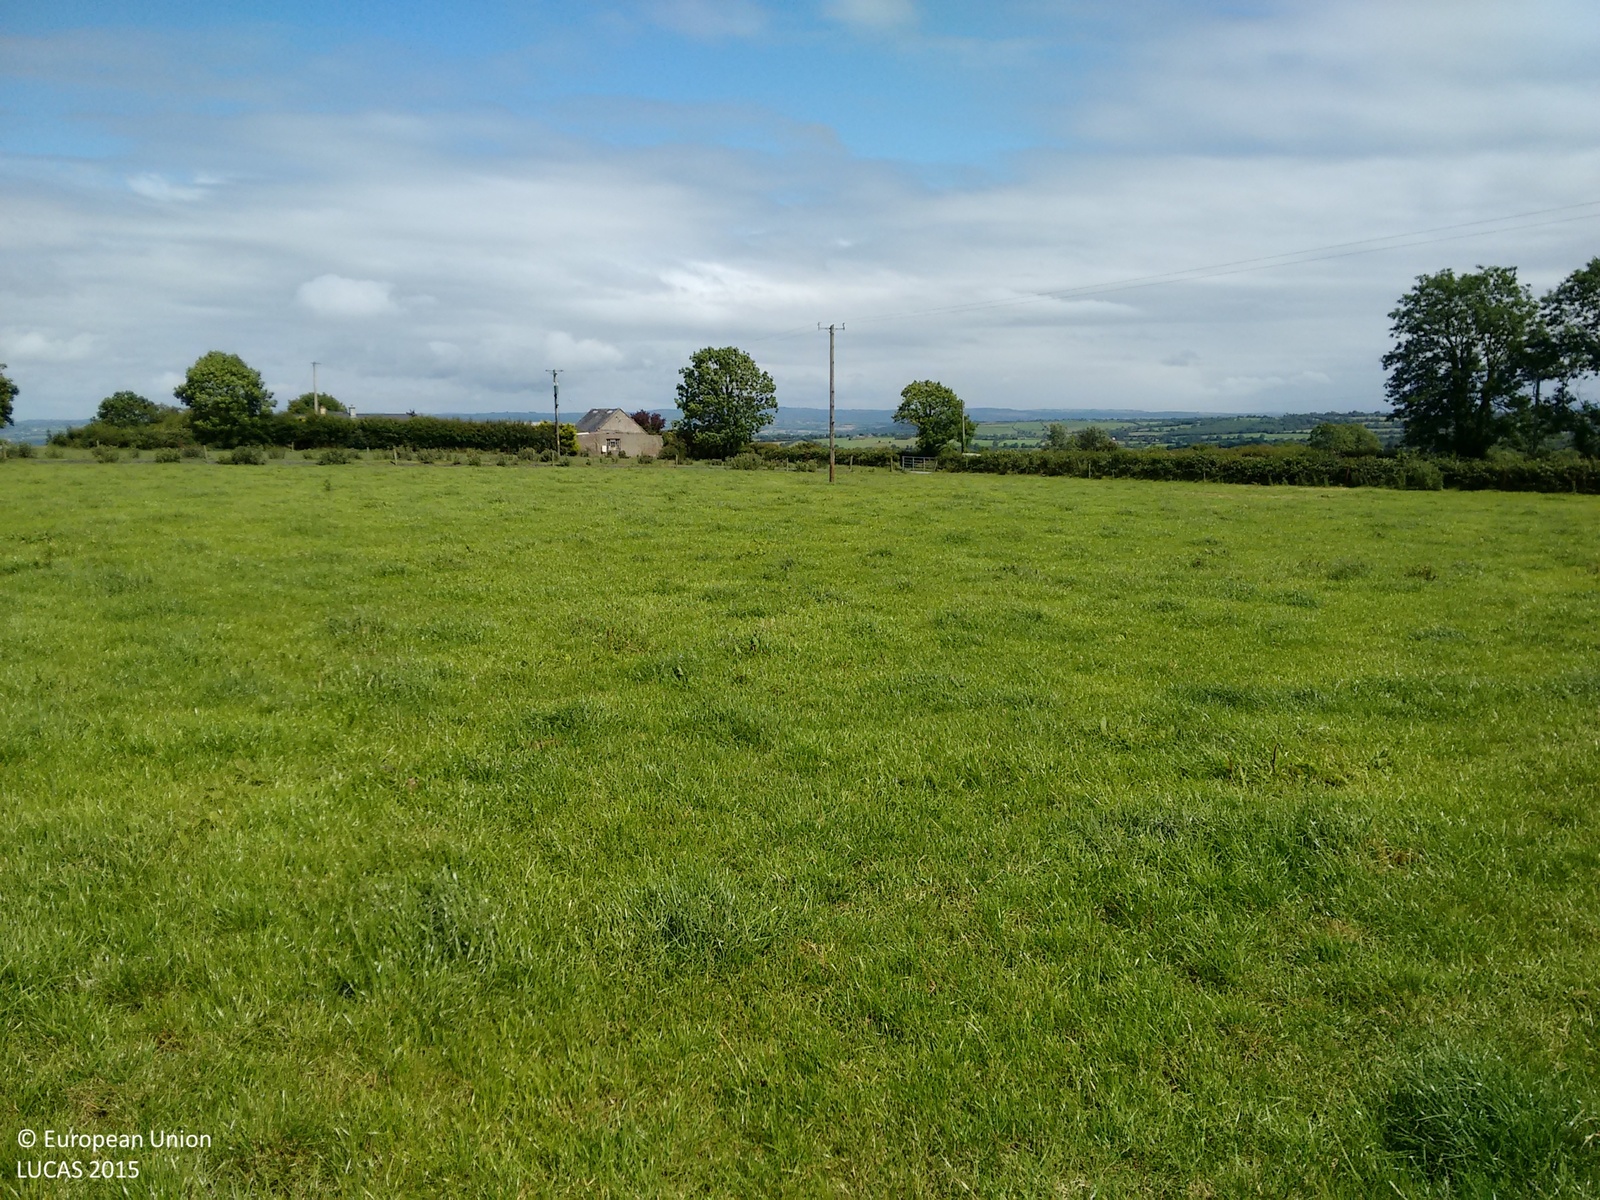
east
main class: Grassland
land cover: Grassland without tree/shrub cover
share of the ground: > 75 %
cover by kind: herbaceous plants 100 %
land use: Agriculture (excluding fallow land and kitchen gardens)
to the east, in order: Grassland without tree/shrub cover; Electric lines; Grassland without tree/shrub cover; Fences; Abandoned hedges; Grass margins; Paved roads, cycling and walking lanes; Grass margins; Ditches and canals; Abandoned hedges; Electric lines; Abandoned hedges; Fences; Grassland without tree/shrub cover; Fences; Abandoned hedges
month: July
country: IE
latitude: 52.6951
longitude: -7.4238
